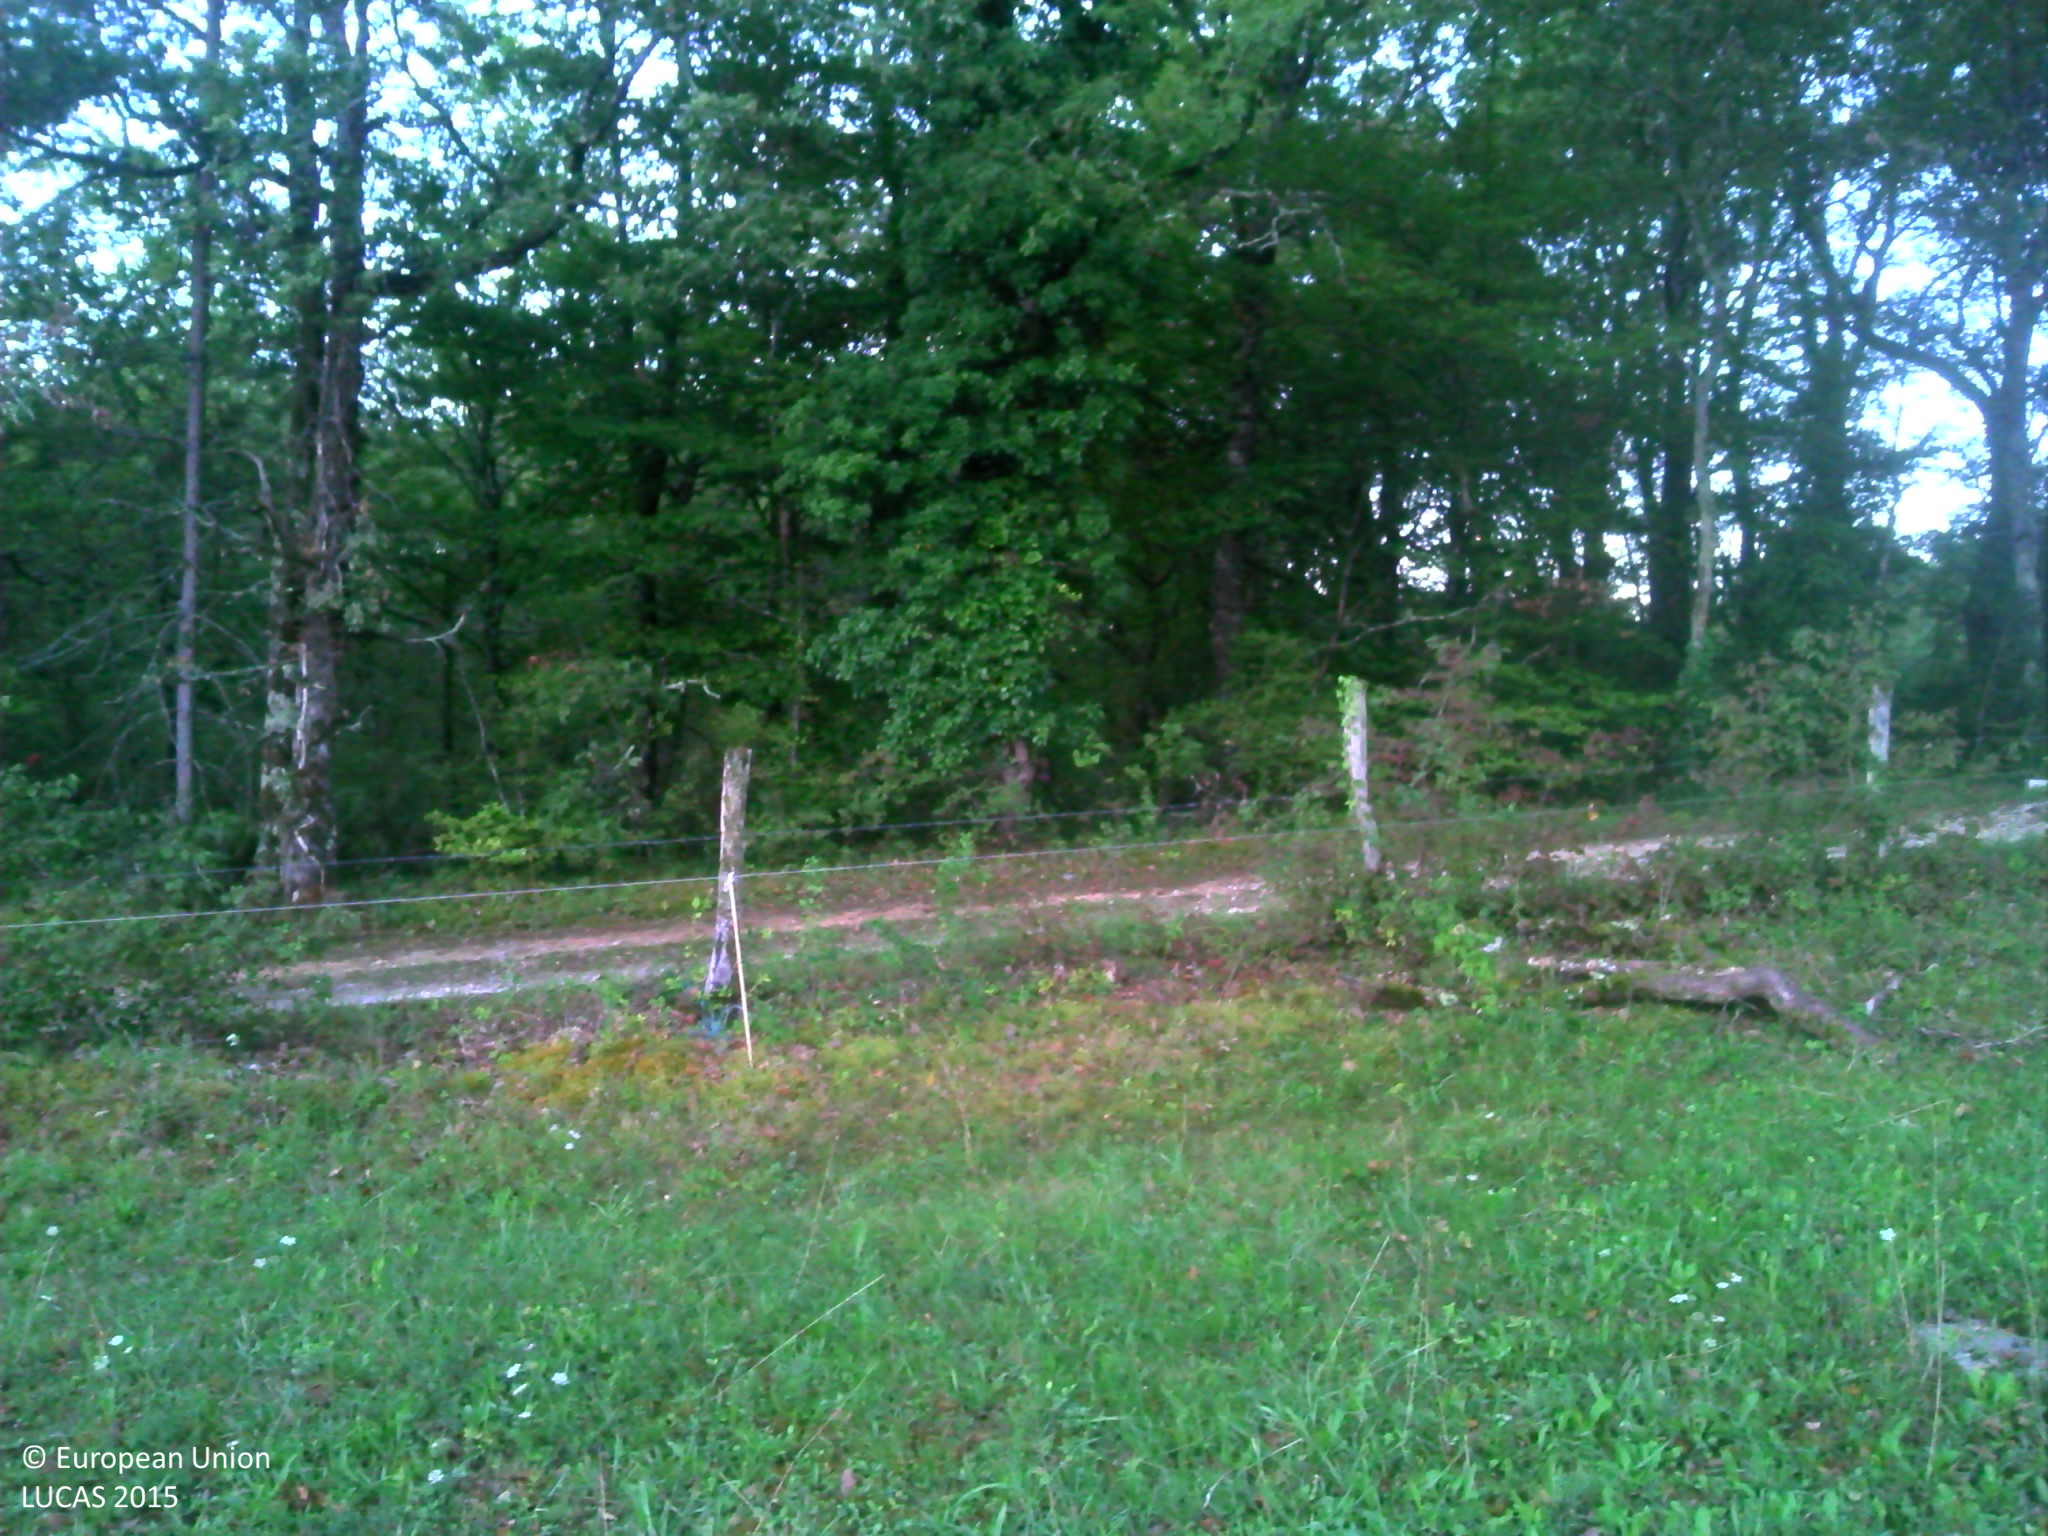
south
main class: Grassland
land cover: Grassland without tree/shrub cover
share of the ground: > 75 %
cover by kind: herbaceous plants 100 %
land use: Agriculture (excluding fallow land and kitchen gardens)
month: August
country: FR
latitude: 44.8137
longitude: 1.4611
